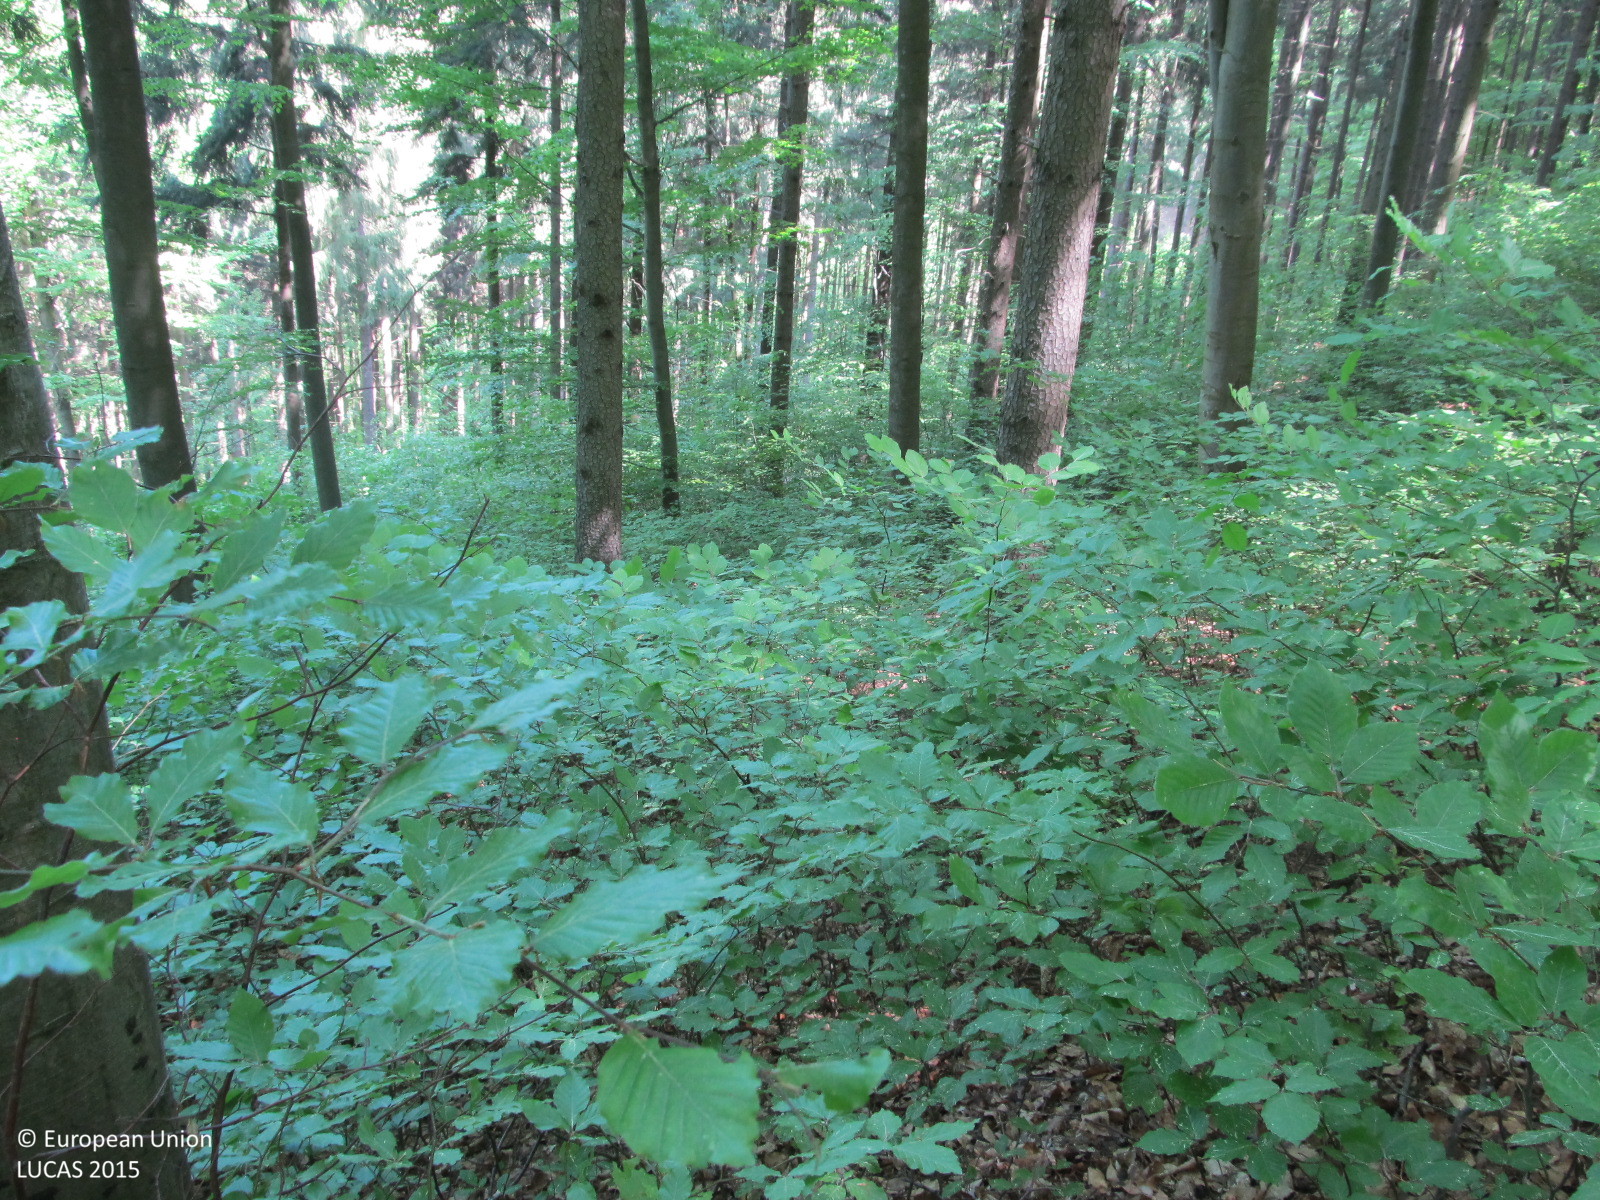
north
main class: Woodland
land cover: Broadleaved woodland
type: beech forest
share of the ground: > 75 %
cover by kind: broadleaved forest trees 60 %, coniferous forest trees 20 %, shrubs 10 %, unconsolidated bare surface 10 %
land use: Forestry
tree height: > 5 m
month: May
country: AT
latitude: 48.6081
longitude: 15.5229
